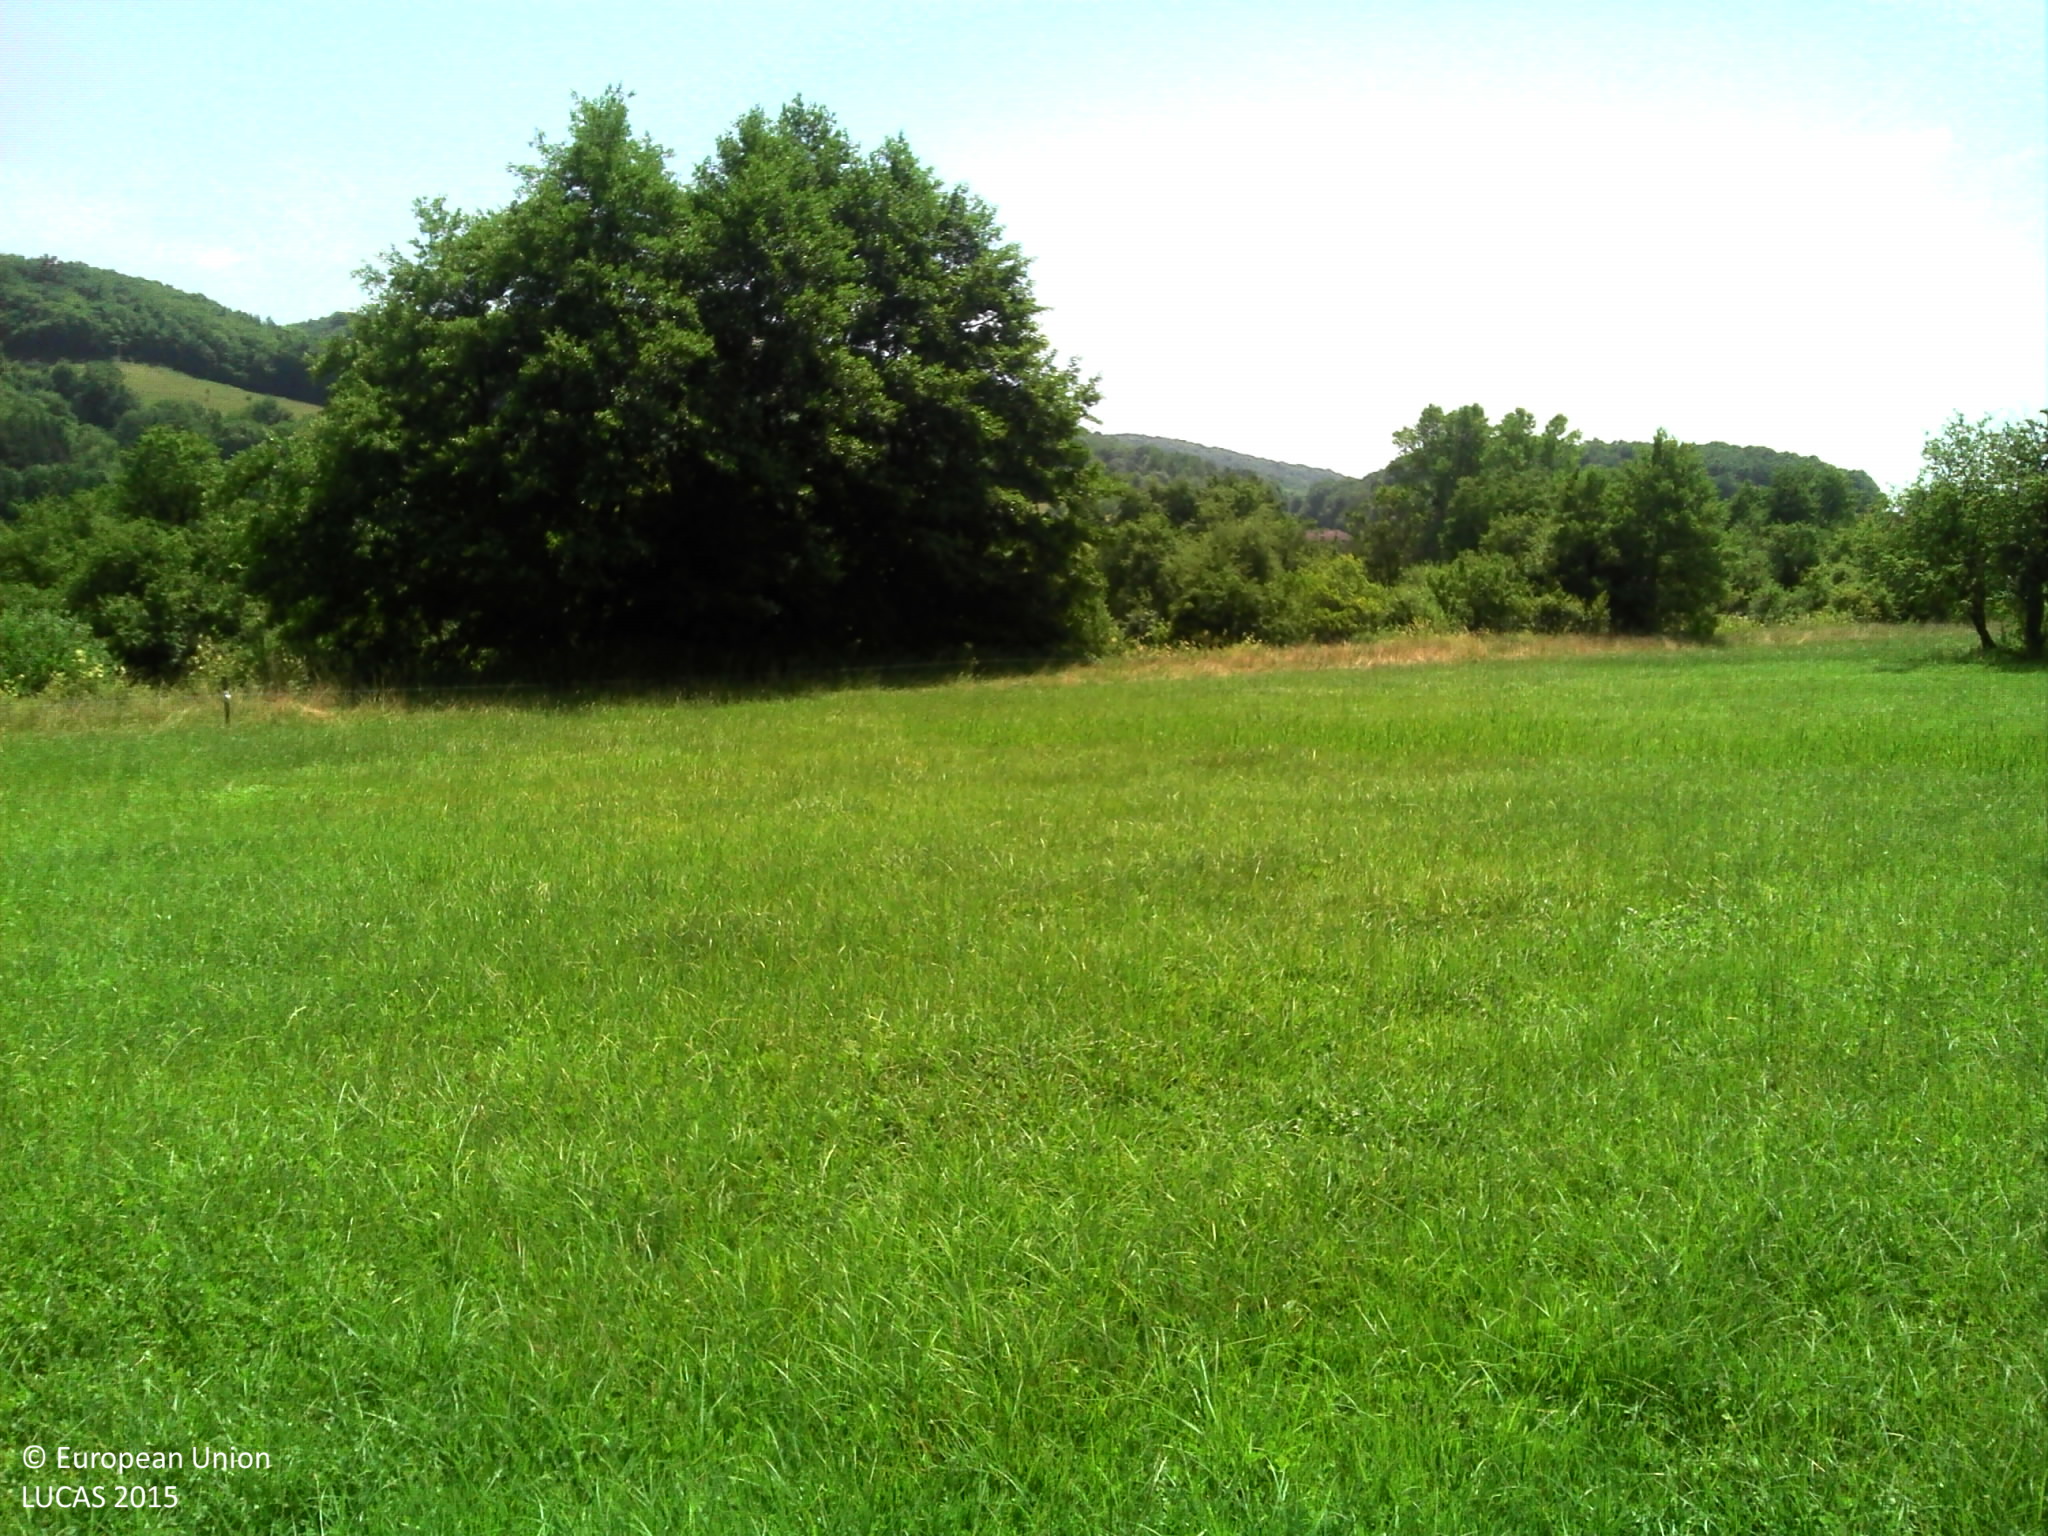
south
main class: Grassland
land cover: Grassland without tree/shrub cover
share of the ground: > 75 %
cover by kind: herbaceous plants 100 %
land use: Agriculture (excluding fallow land and kitchen gardens)
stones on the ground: < 10 %
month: July
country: FR
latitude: 45.4791
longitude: 5.4632
